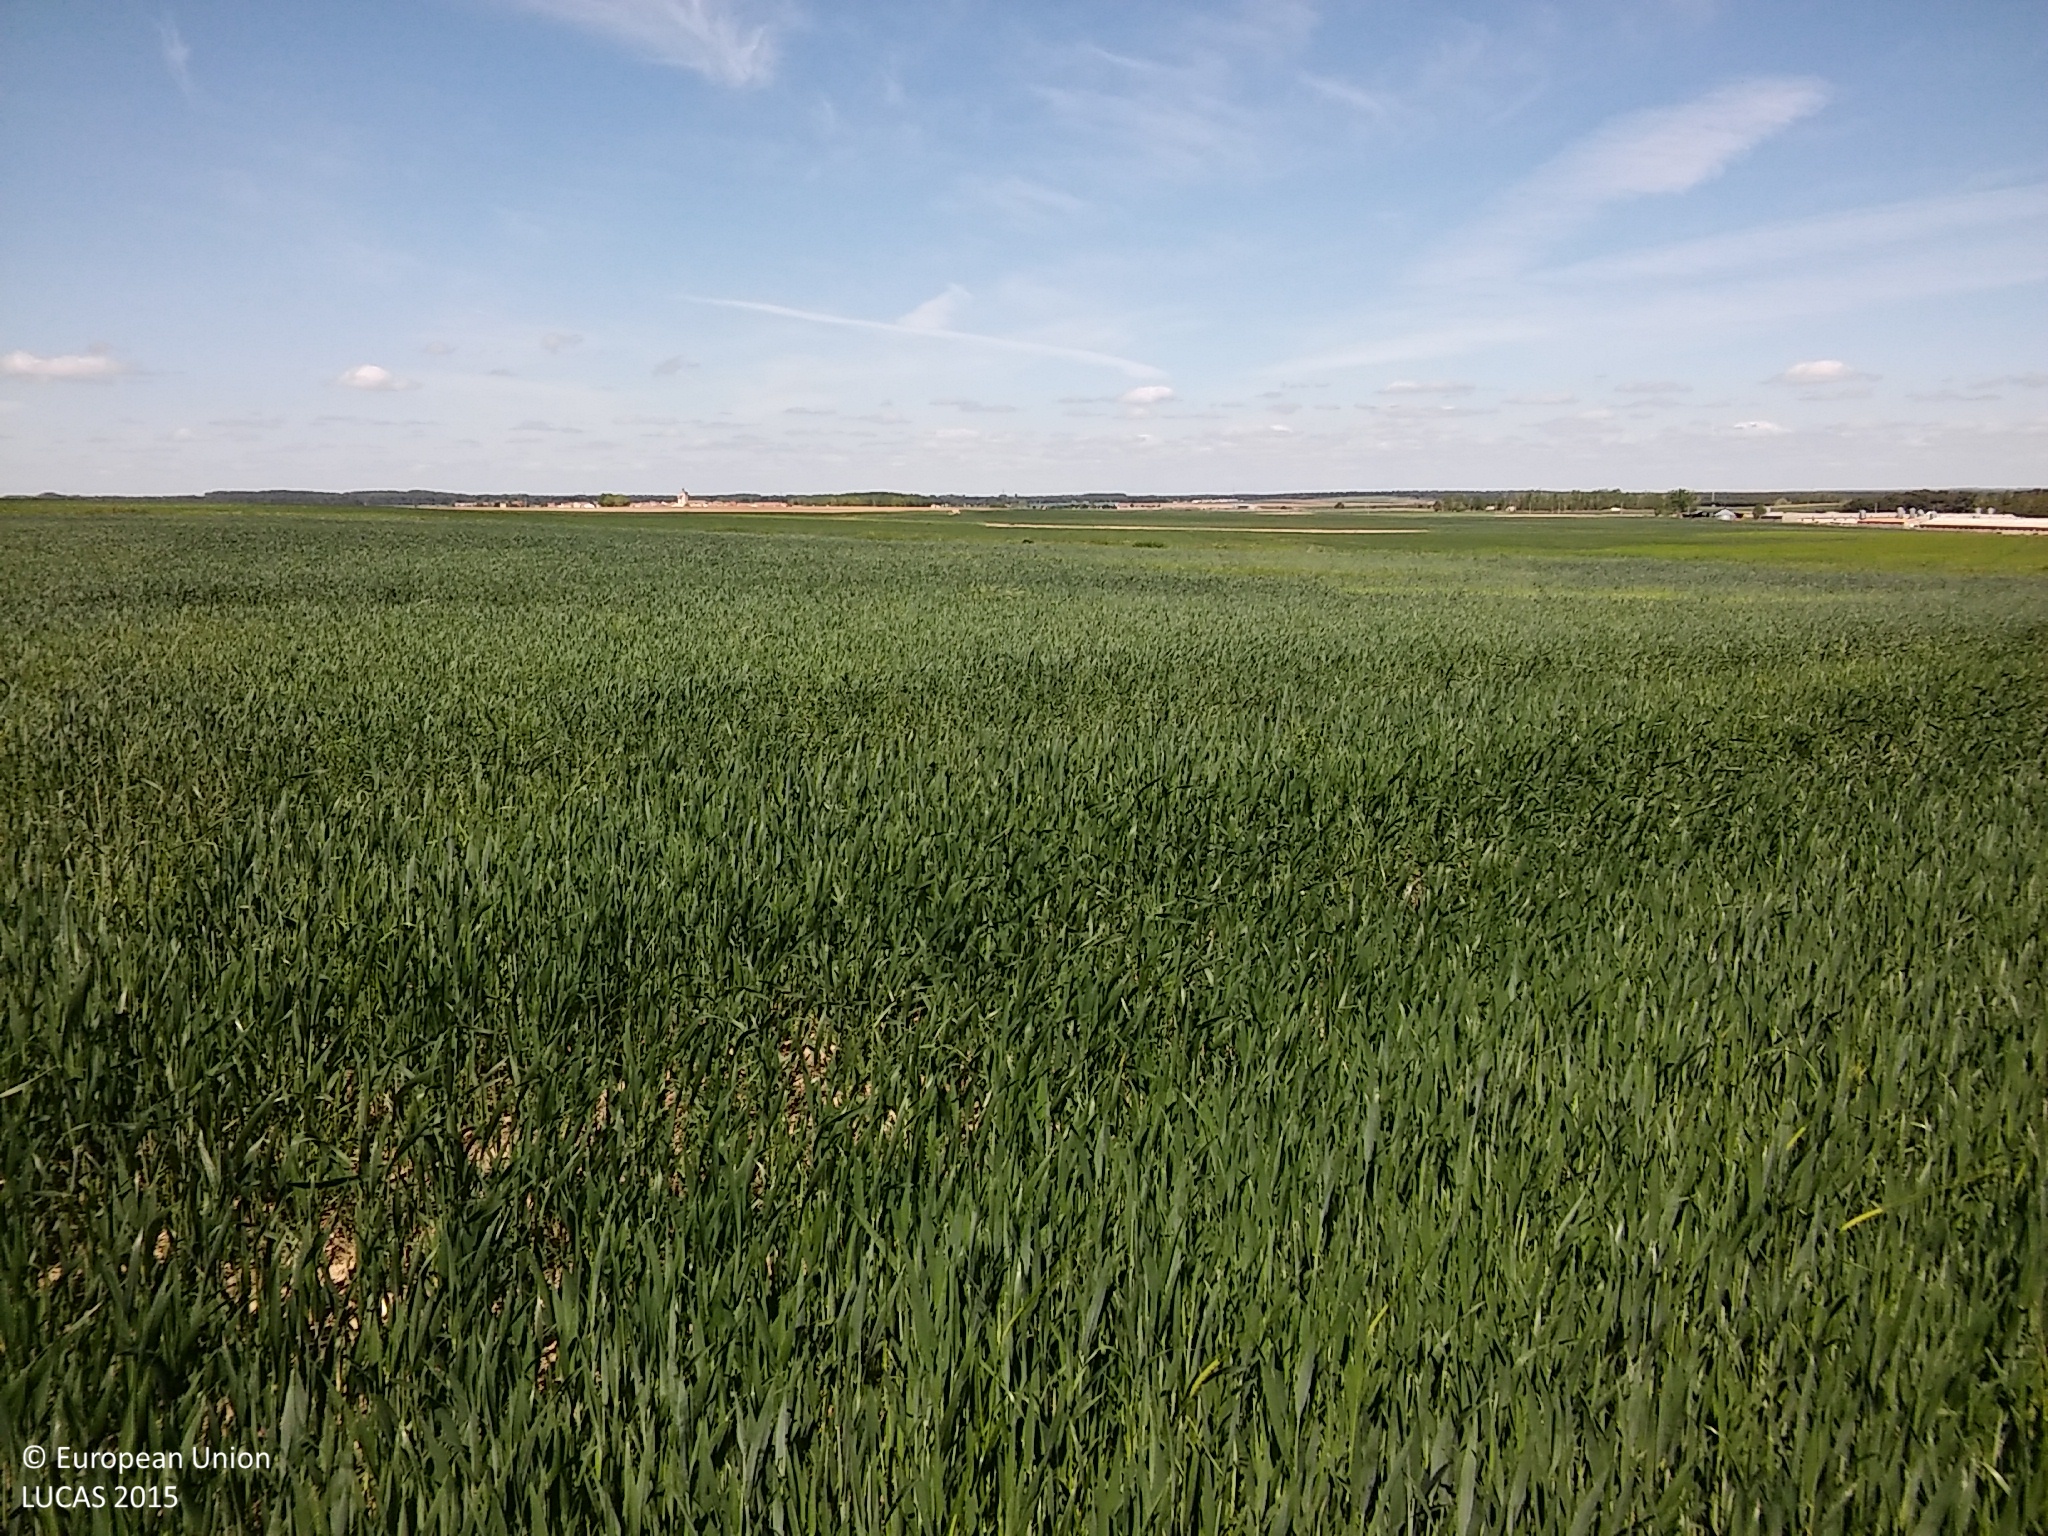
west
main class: Cropland
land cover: Common wheat
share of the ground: > 75 %
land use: Agriculture (excluding fallow land and kitchen gardens)
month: May
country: ES
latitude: 41.1870
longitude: -3.9643
